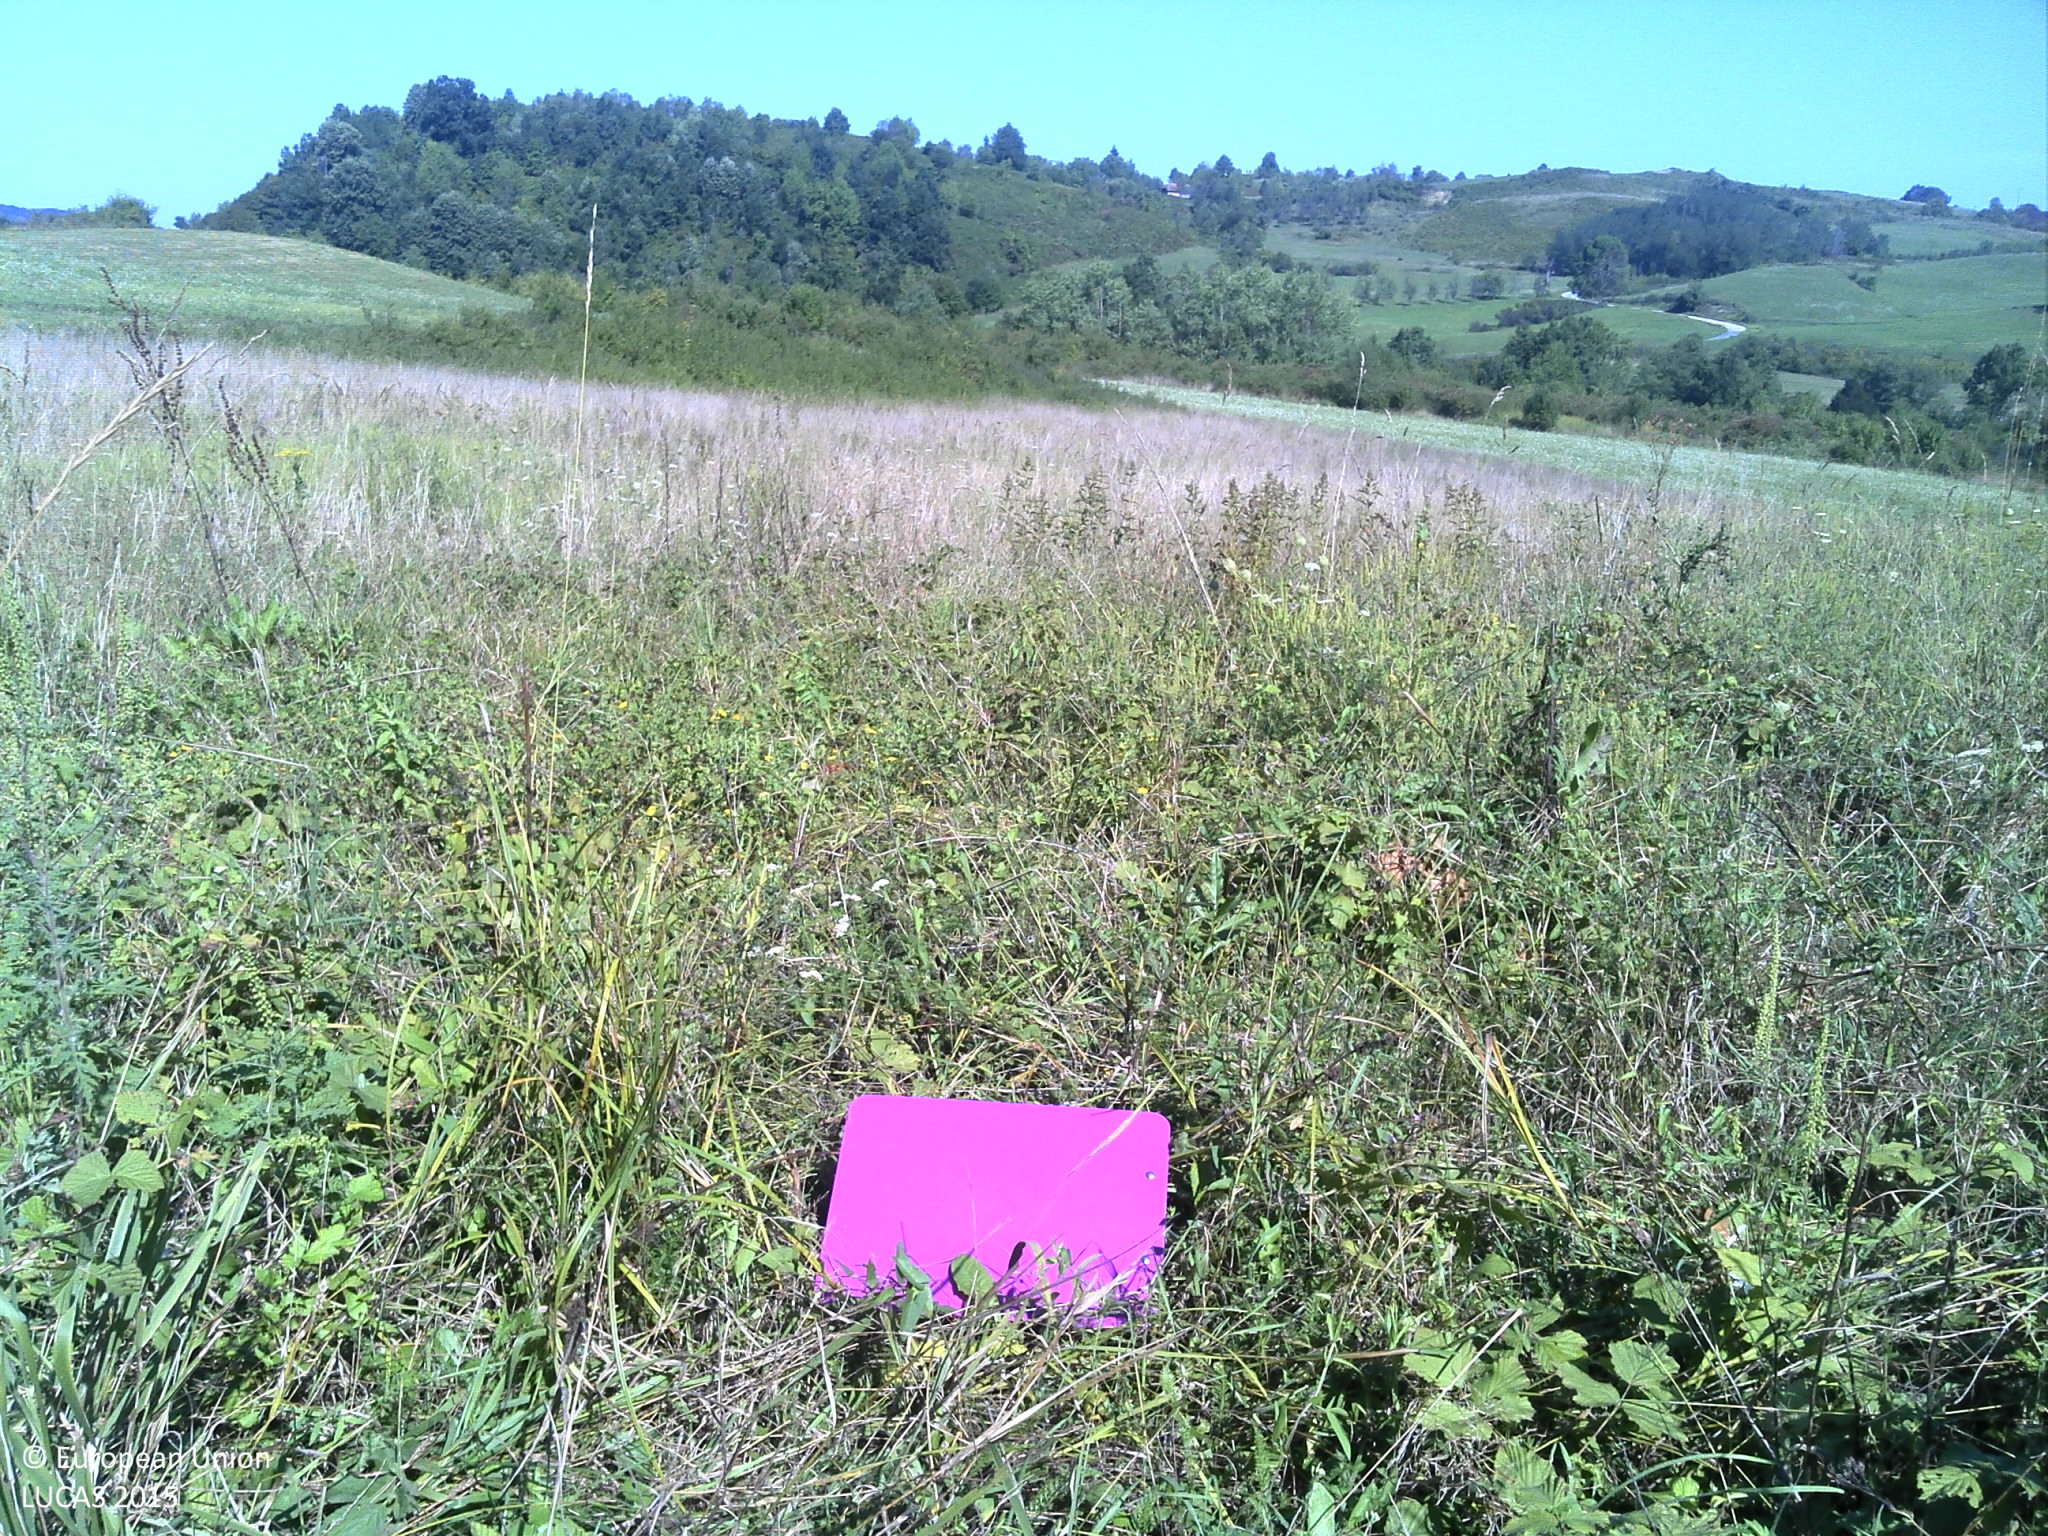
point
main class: Grassland
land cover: Spontaneously vegetated surfaces
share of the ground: > 75 %
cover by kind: herbaceous plants 100 %
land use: Semi-natural and natural areas not in use
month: August
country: HR
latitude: 45.2318
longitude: 16.1997
